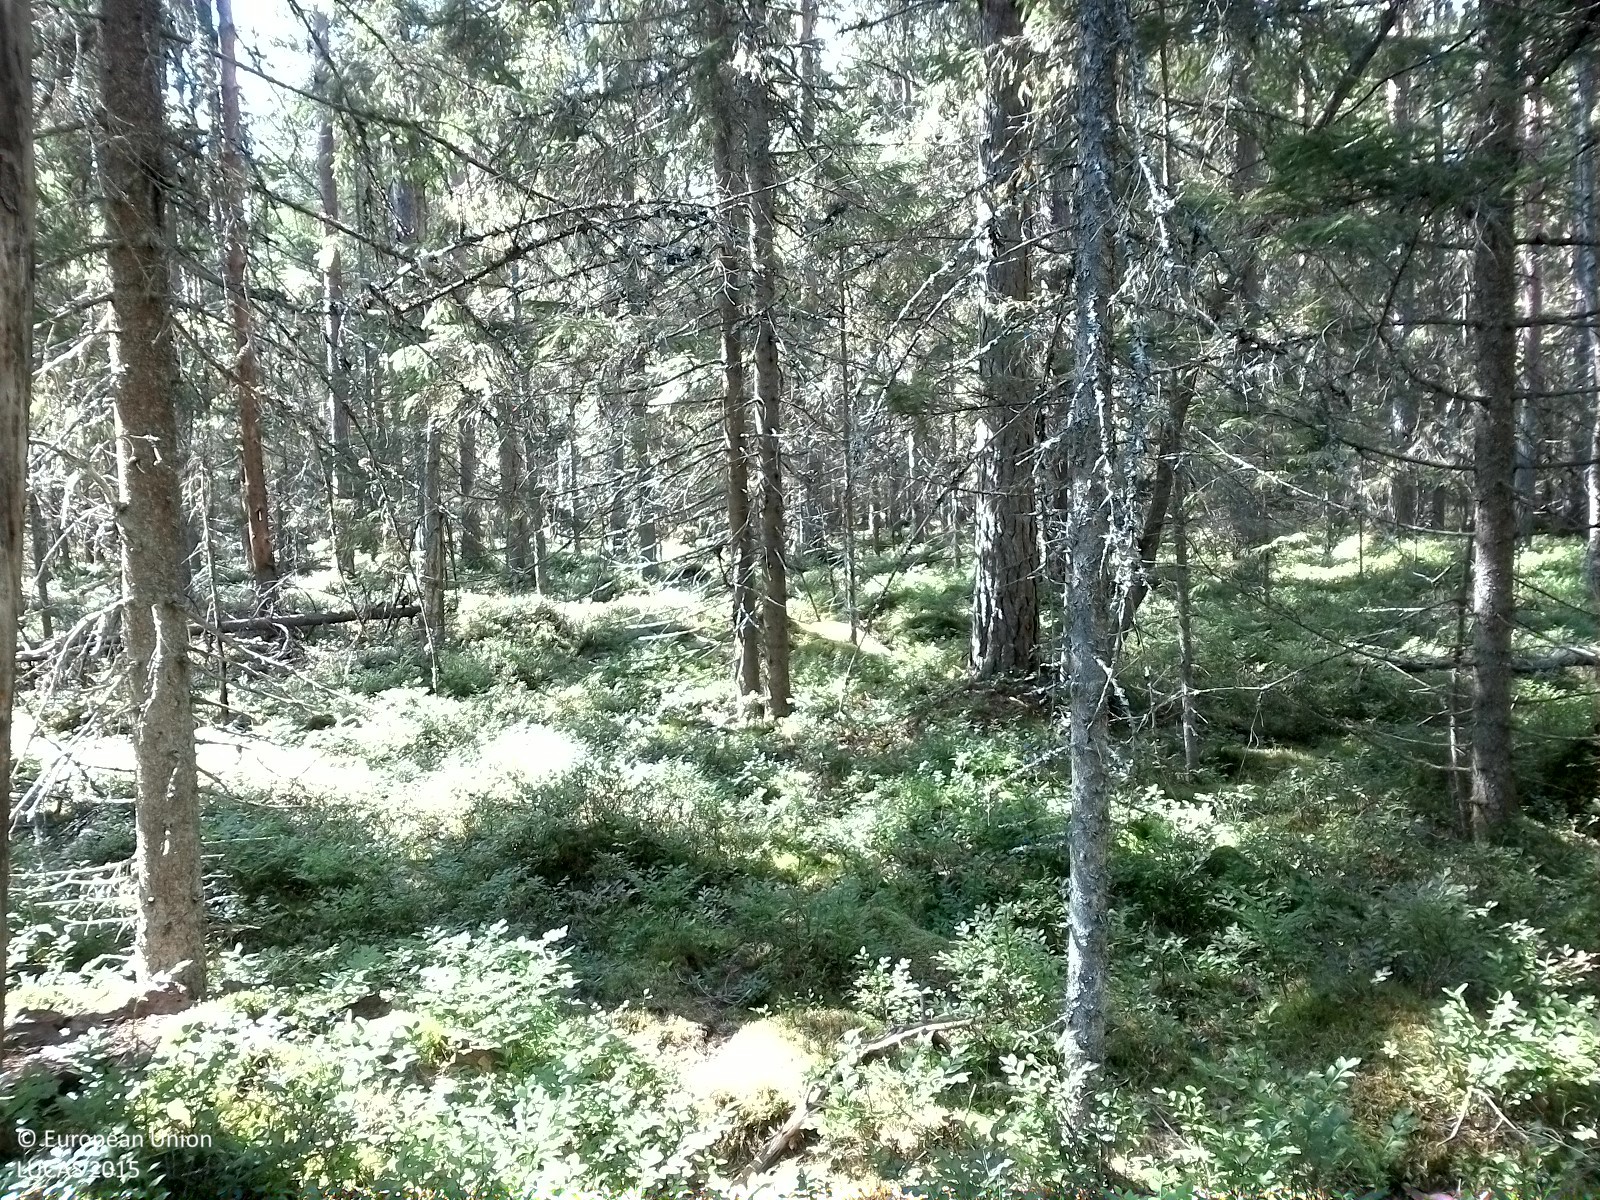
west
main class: Woodland
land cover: Pine dominated coniferous woodland
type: boreal forest
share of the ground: 25 - 50 %
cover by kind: coniferous forest trees 40 %, herbaceous plants 40 %, lichens and mosses 20 %
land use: Forestry
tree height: > 5 m
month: August
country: SE
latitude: 58.9408
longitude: 15.3972
